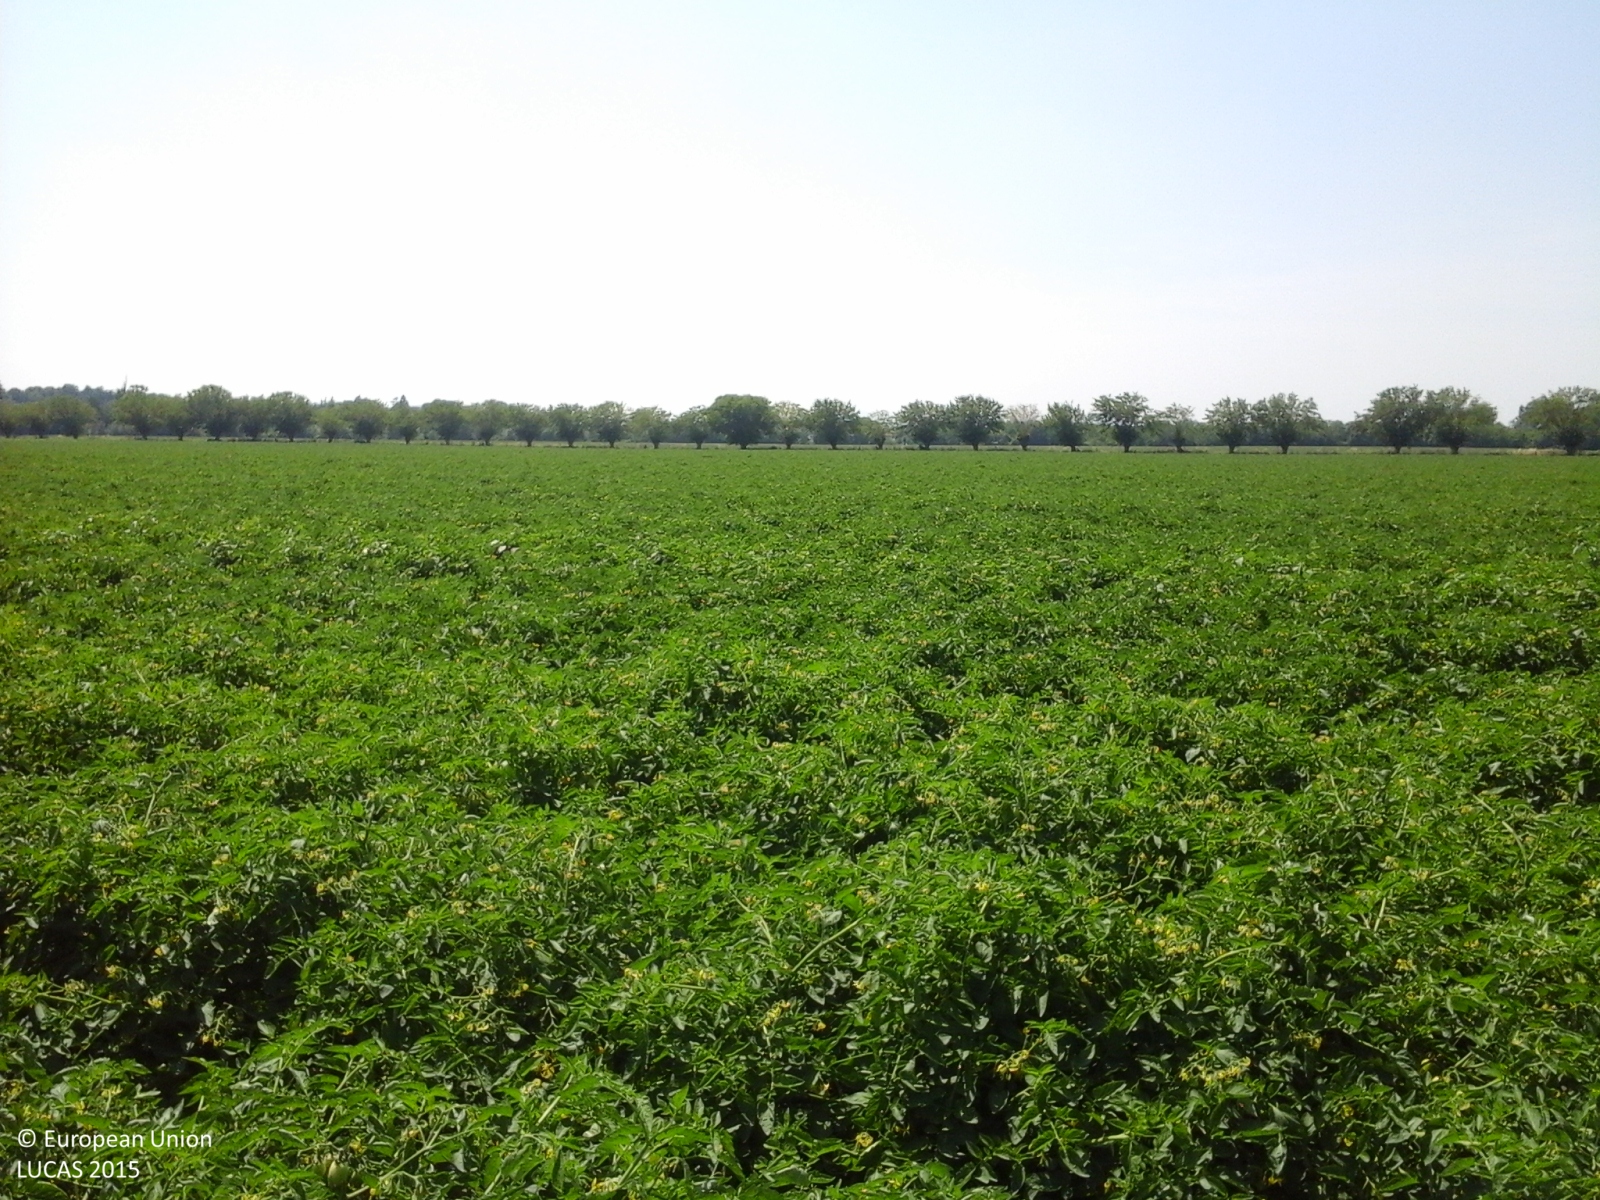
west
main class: Cropland
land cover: Tomatoes
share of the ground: > 75 %
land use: Agriculture (excluding fallow land and kitchen gardens)
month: June
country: IT
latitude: 44.7289
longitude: 10.2898
